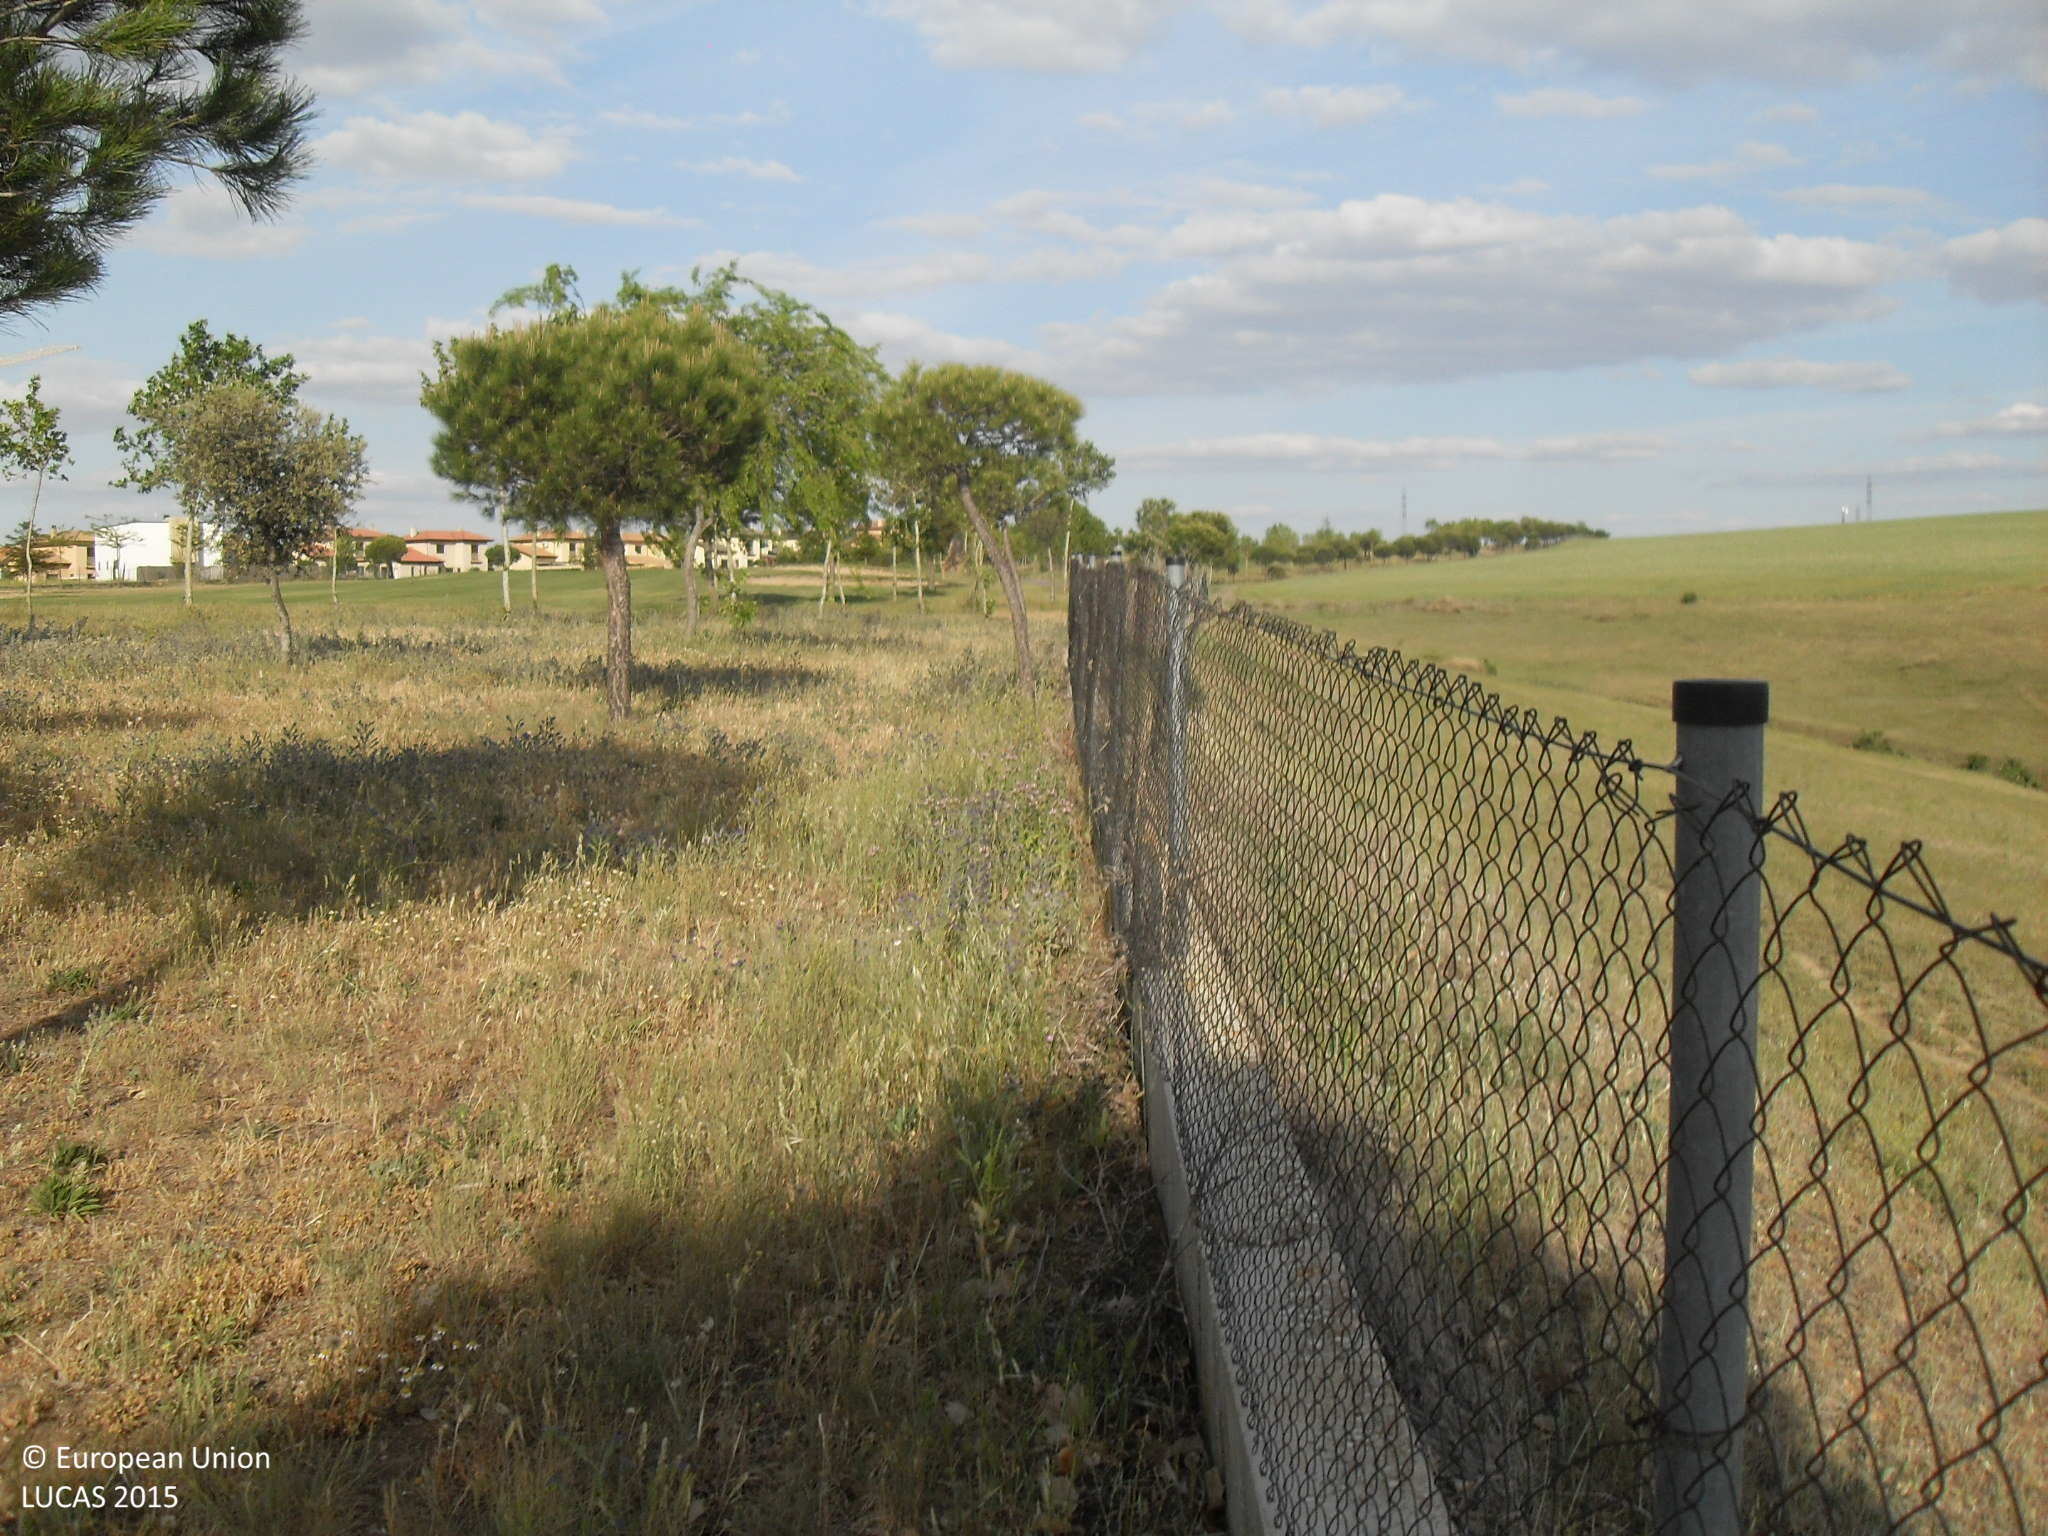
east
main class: Grassland
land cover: Grassland without tree/shrub cover
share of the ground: > 75 %
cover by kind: herbaceous plants 100 %
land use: Agriculture (excluding fallow land and kitchen gardens)
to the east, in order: Grassland without tree/shrub cover; Fences; Grass margins; Tracks; Grassland without tree/shrub cover
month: May
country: ES
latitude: 40.9788
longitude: -5.7066
